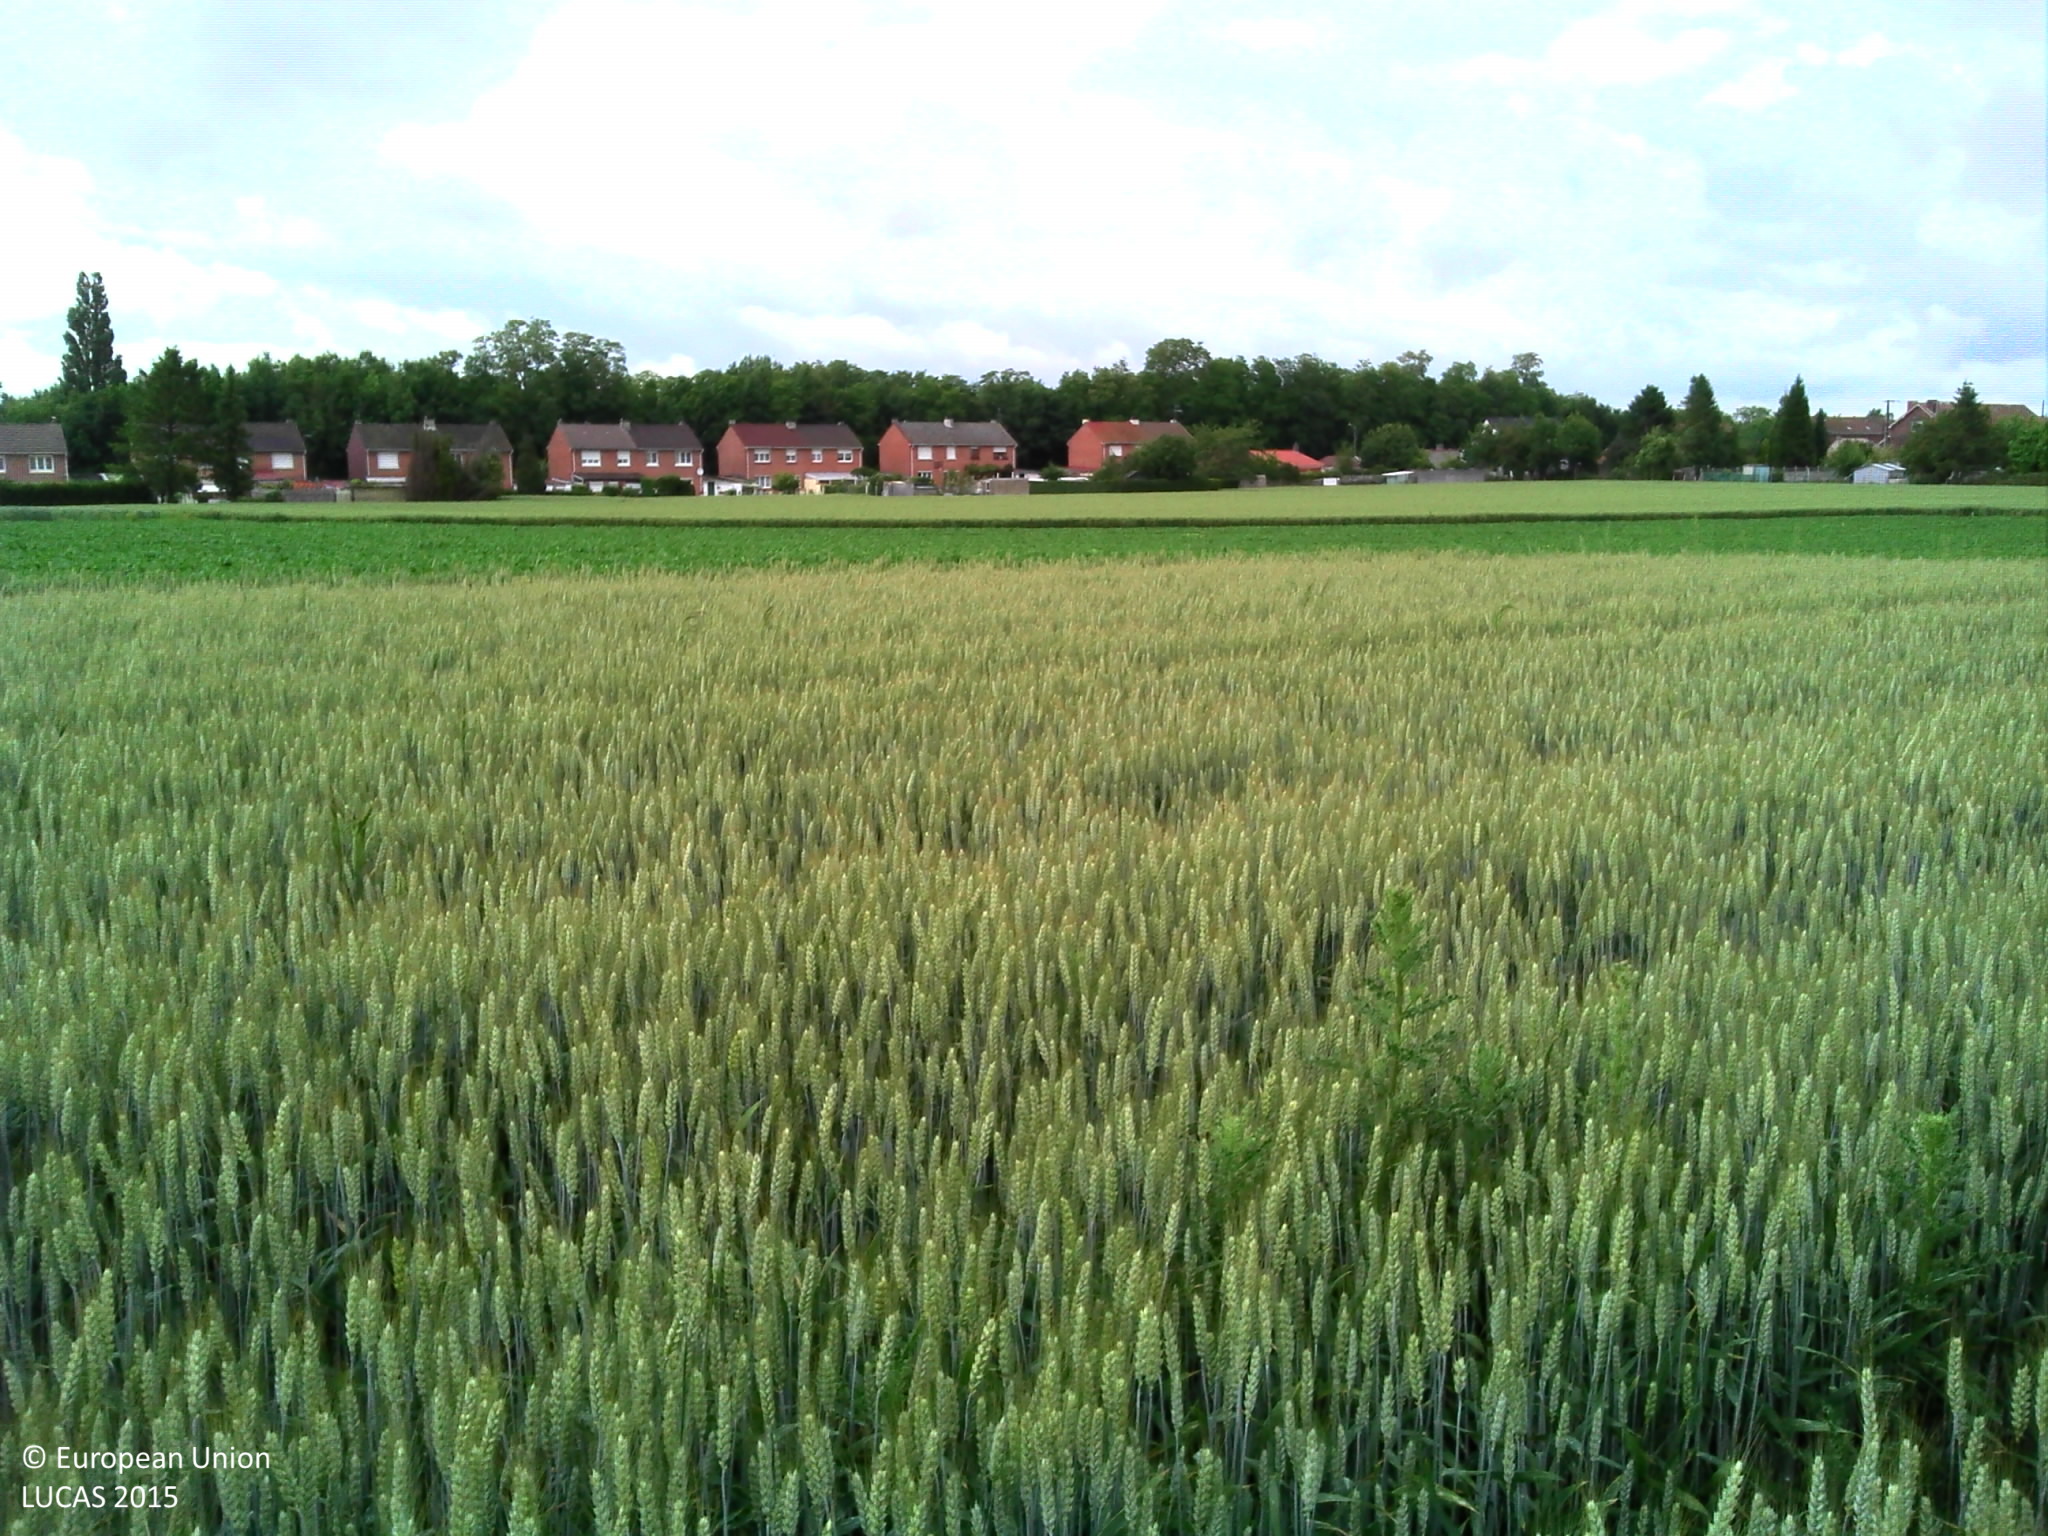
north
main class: Cropland
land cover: Common wheat
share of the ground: > 75 %
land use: Agriculture (excluding fallow land and kitchen gardens)
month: June
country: FR
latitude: 50.4952
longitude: 2.4736
